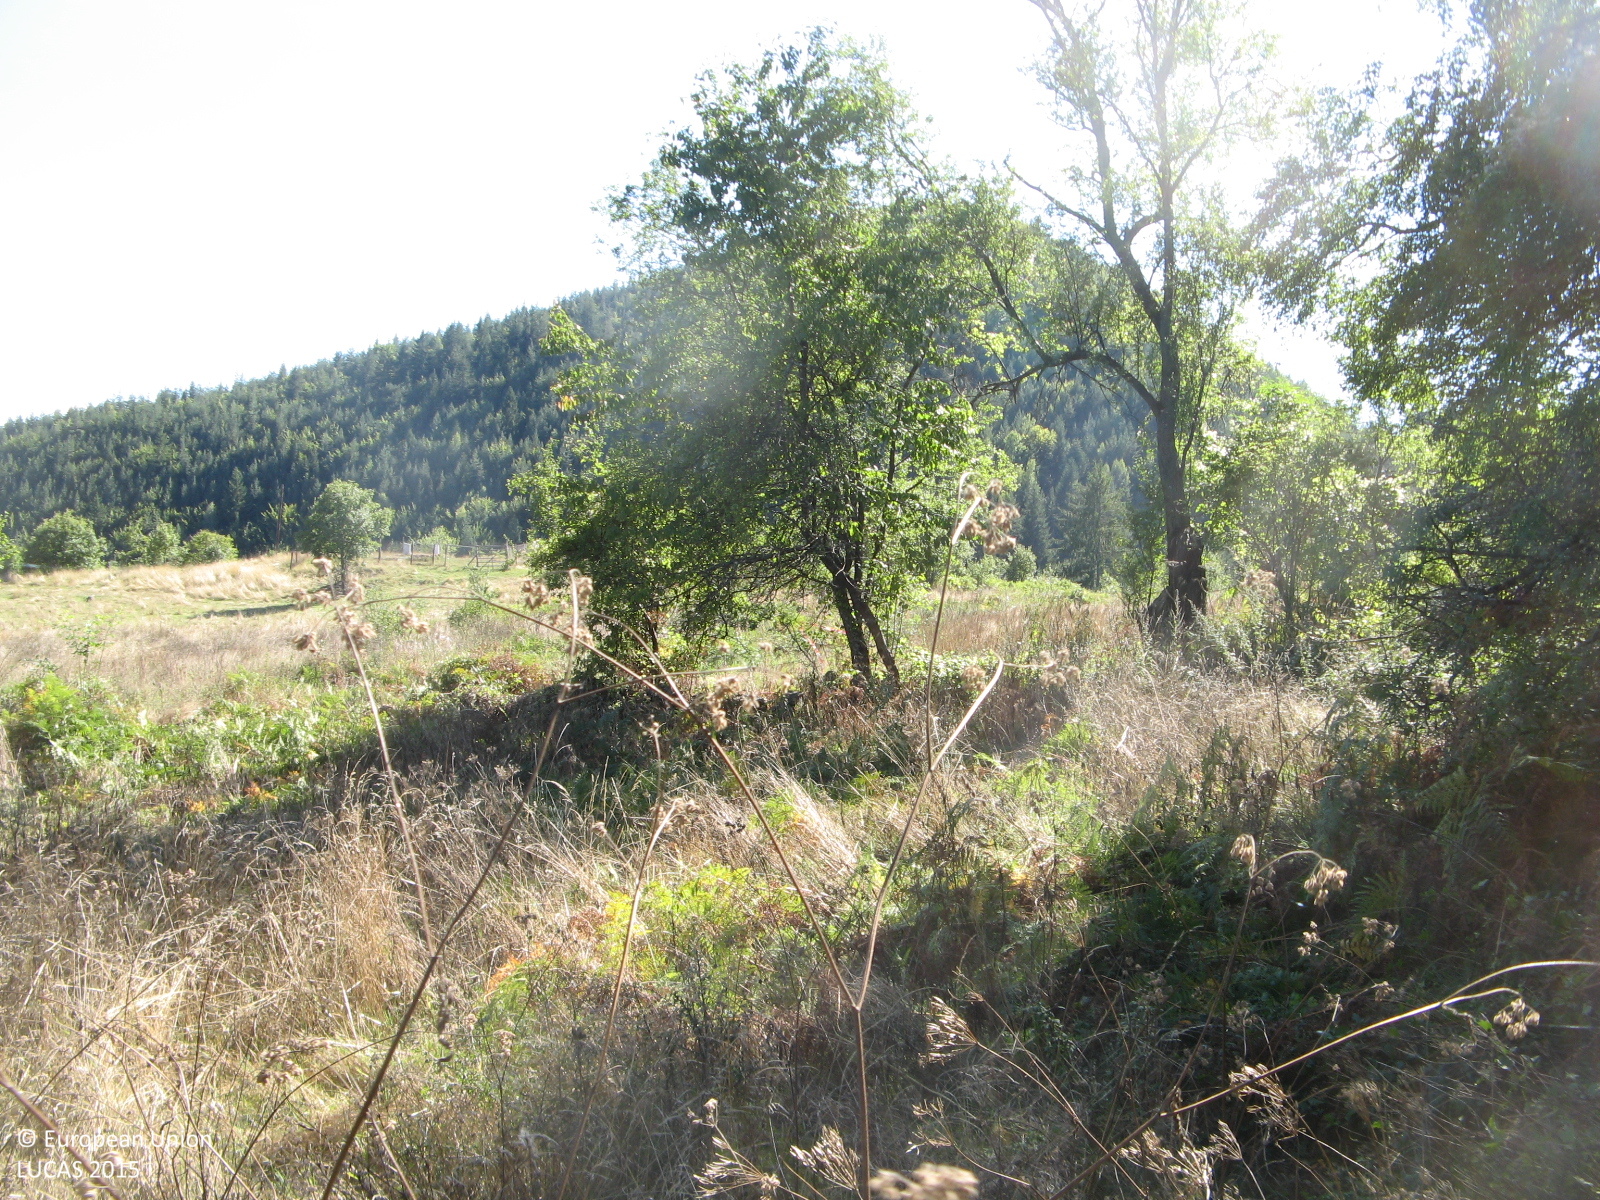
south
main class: Grassland
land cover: Grassland with sparse tree/shrub cover
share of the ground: > 75 %
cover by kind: herbaceous plants 85 %, shrubs 10 %, broadleaved forest trees 5 %
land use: Agriculture (excluding fallow land and kitchen gardens)
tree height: > 5 m
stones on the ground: < 10 %
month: October
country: BG
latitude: 41.5908
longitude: 24.7156
